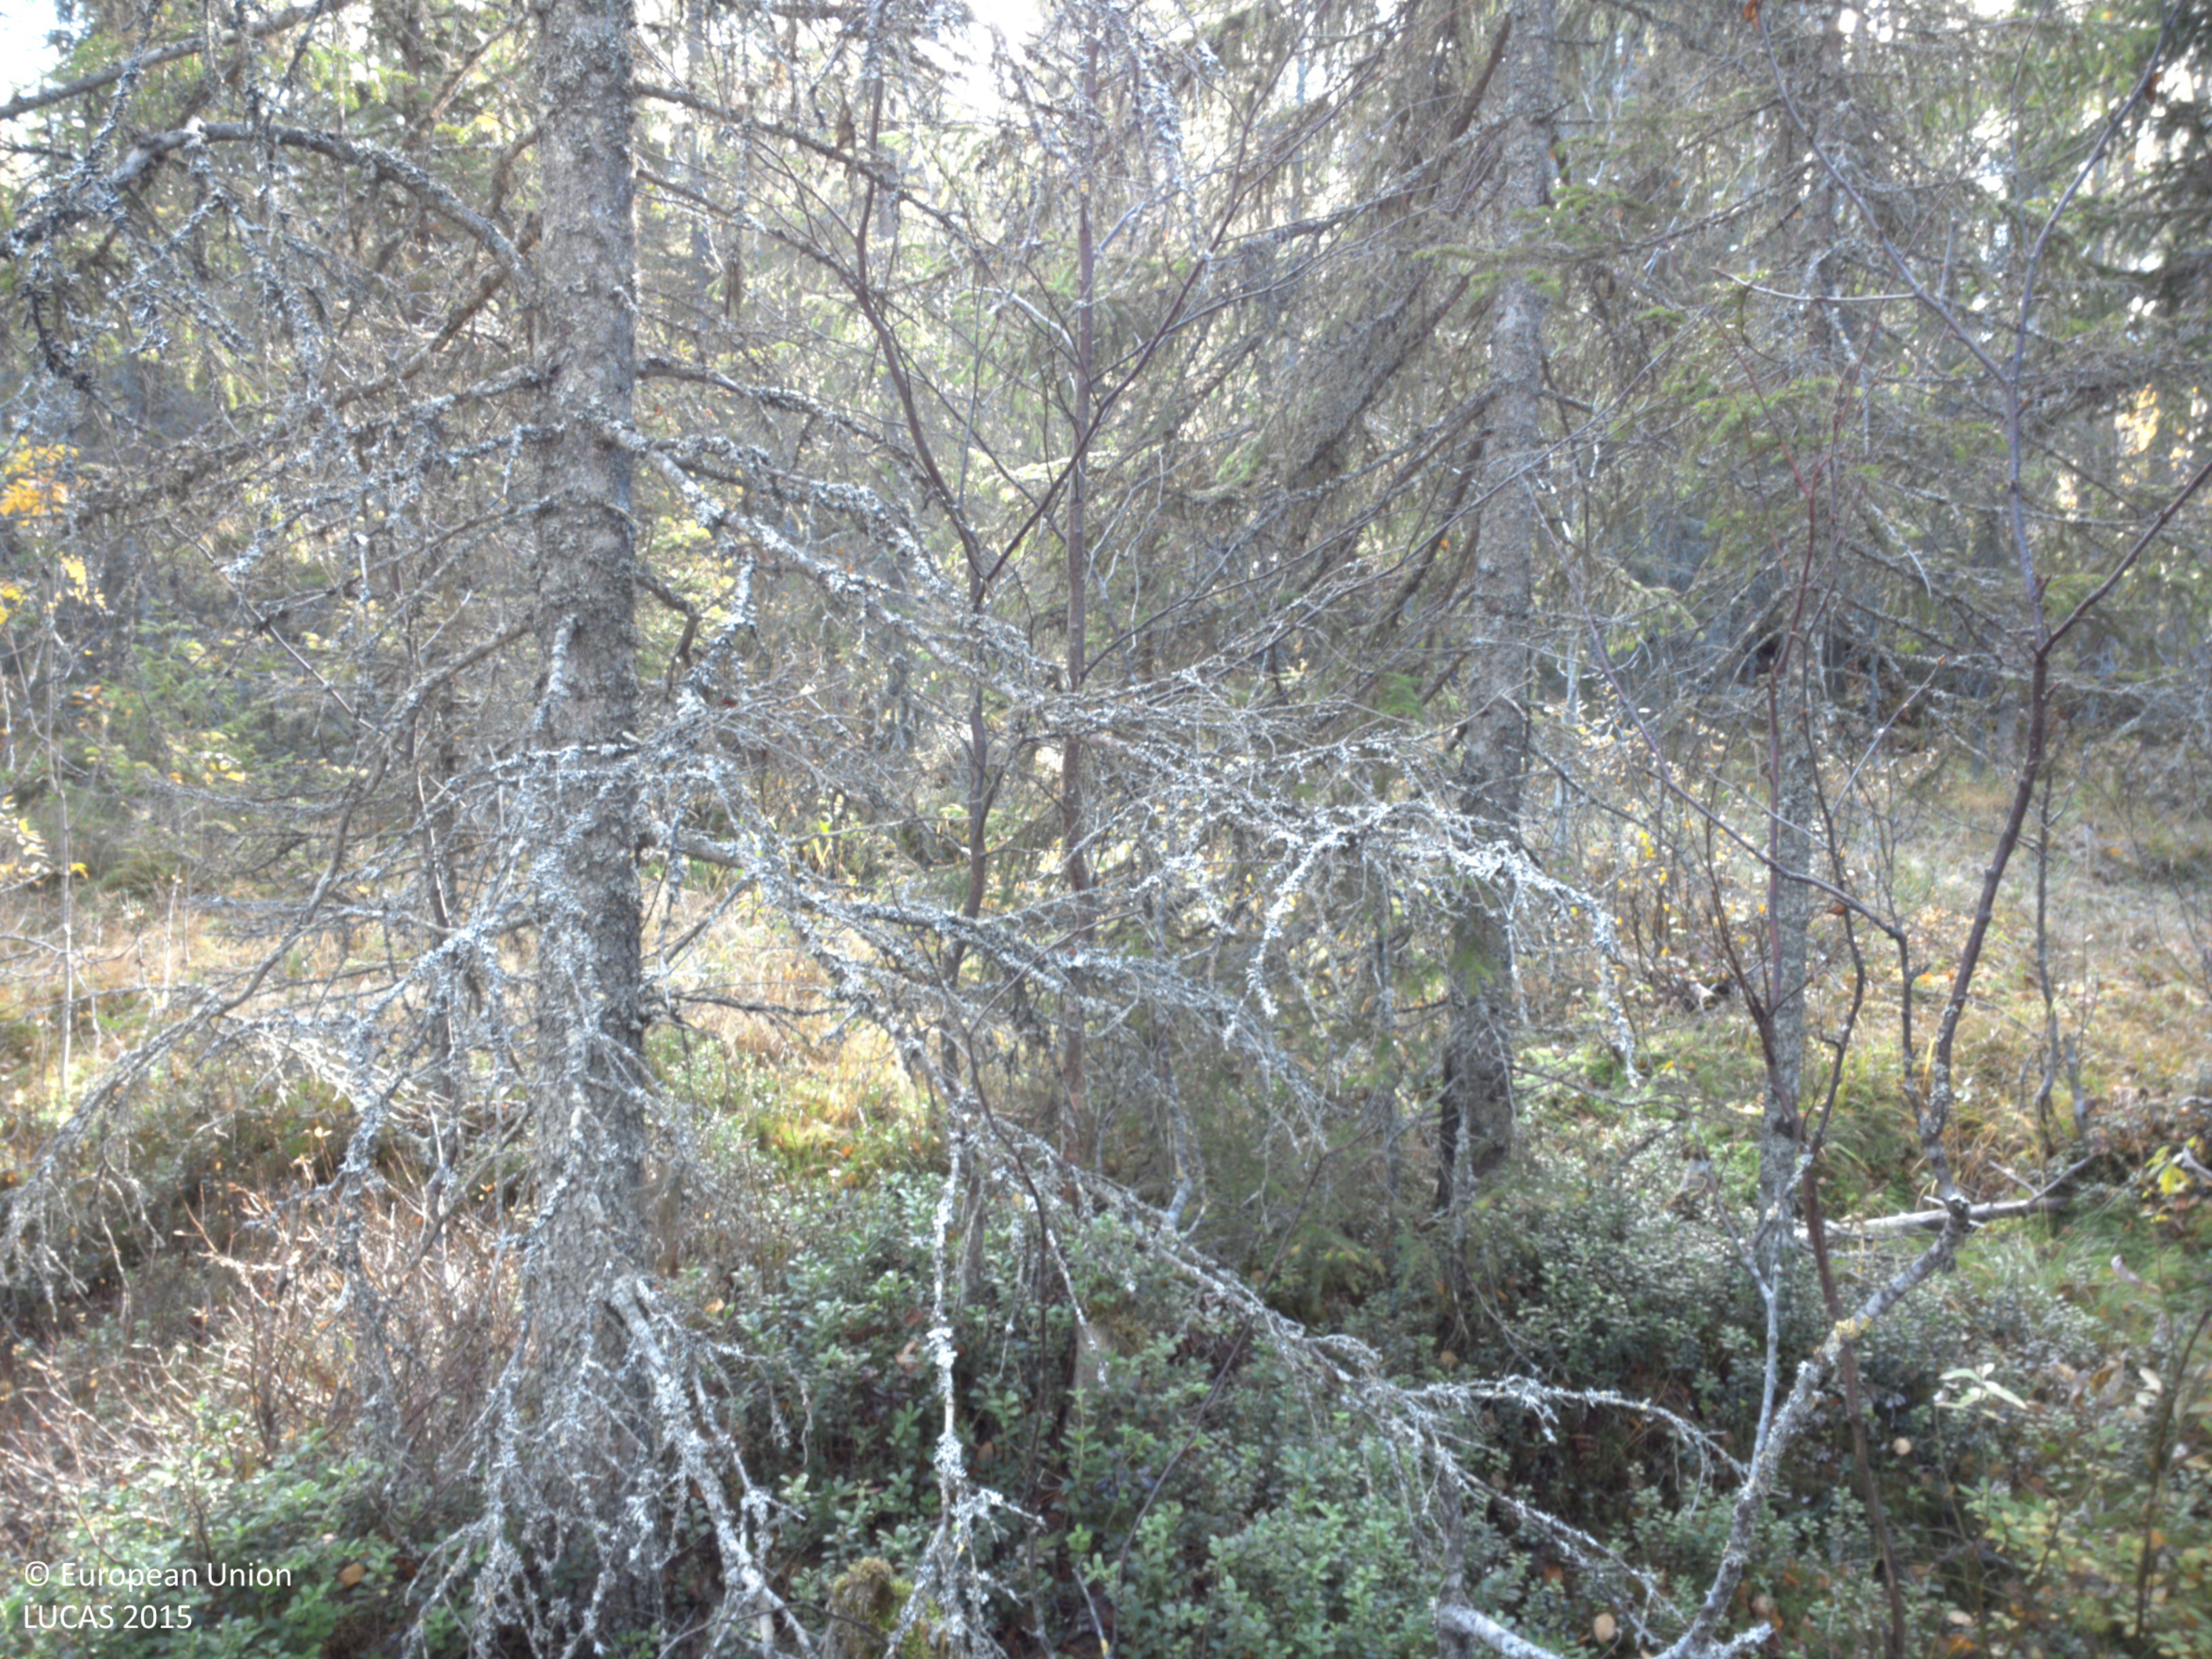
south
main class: Woodland
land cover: Other mixed woodland
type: boreal forest
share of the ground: 50 - 75 %
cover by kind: coniferous forest trees 45 %, shrubs 35 %, broadleaved forest trees 15 %, herbaceous plants 5 %
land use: Forestry
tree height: > 5 m
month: October
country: SE
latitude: 64.6312
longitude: 18.0203
